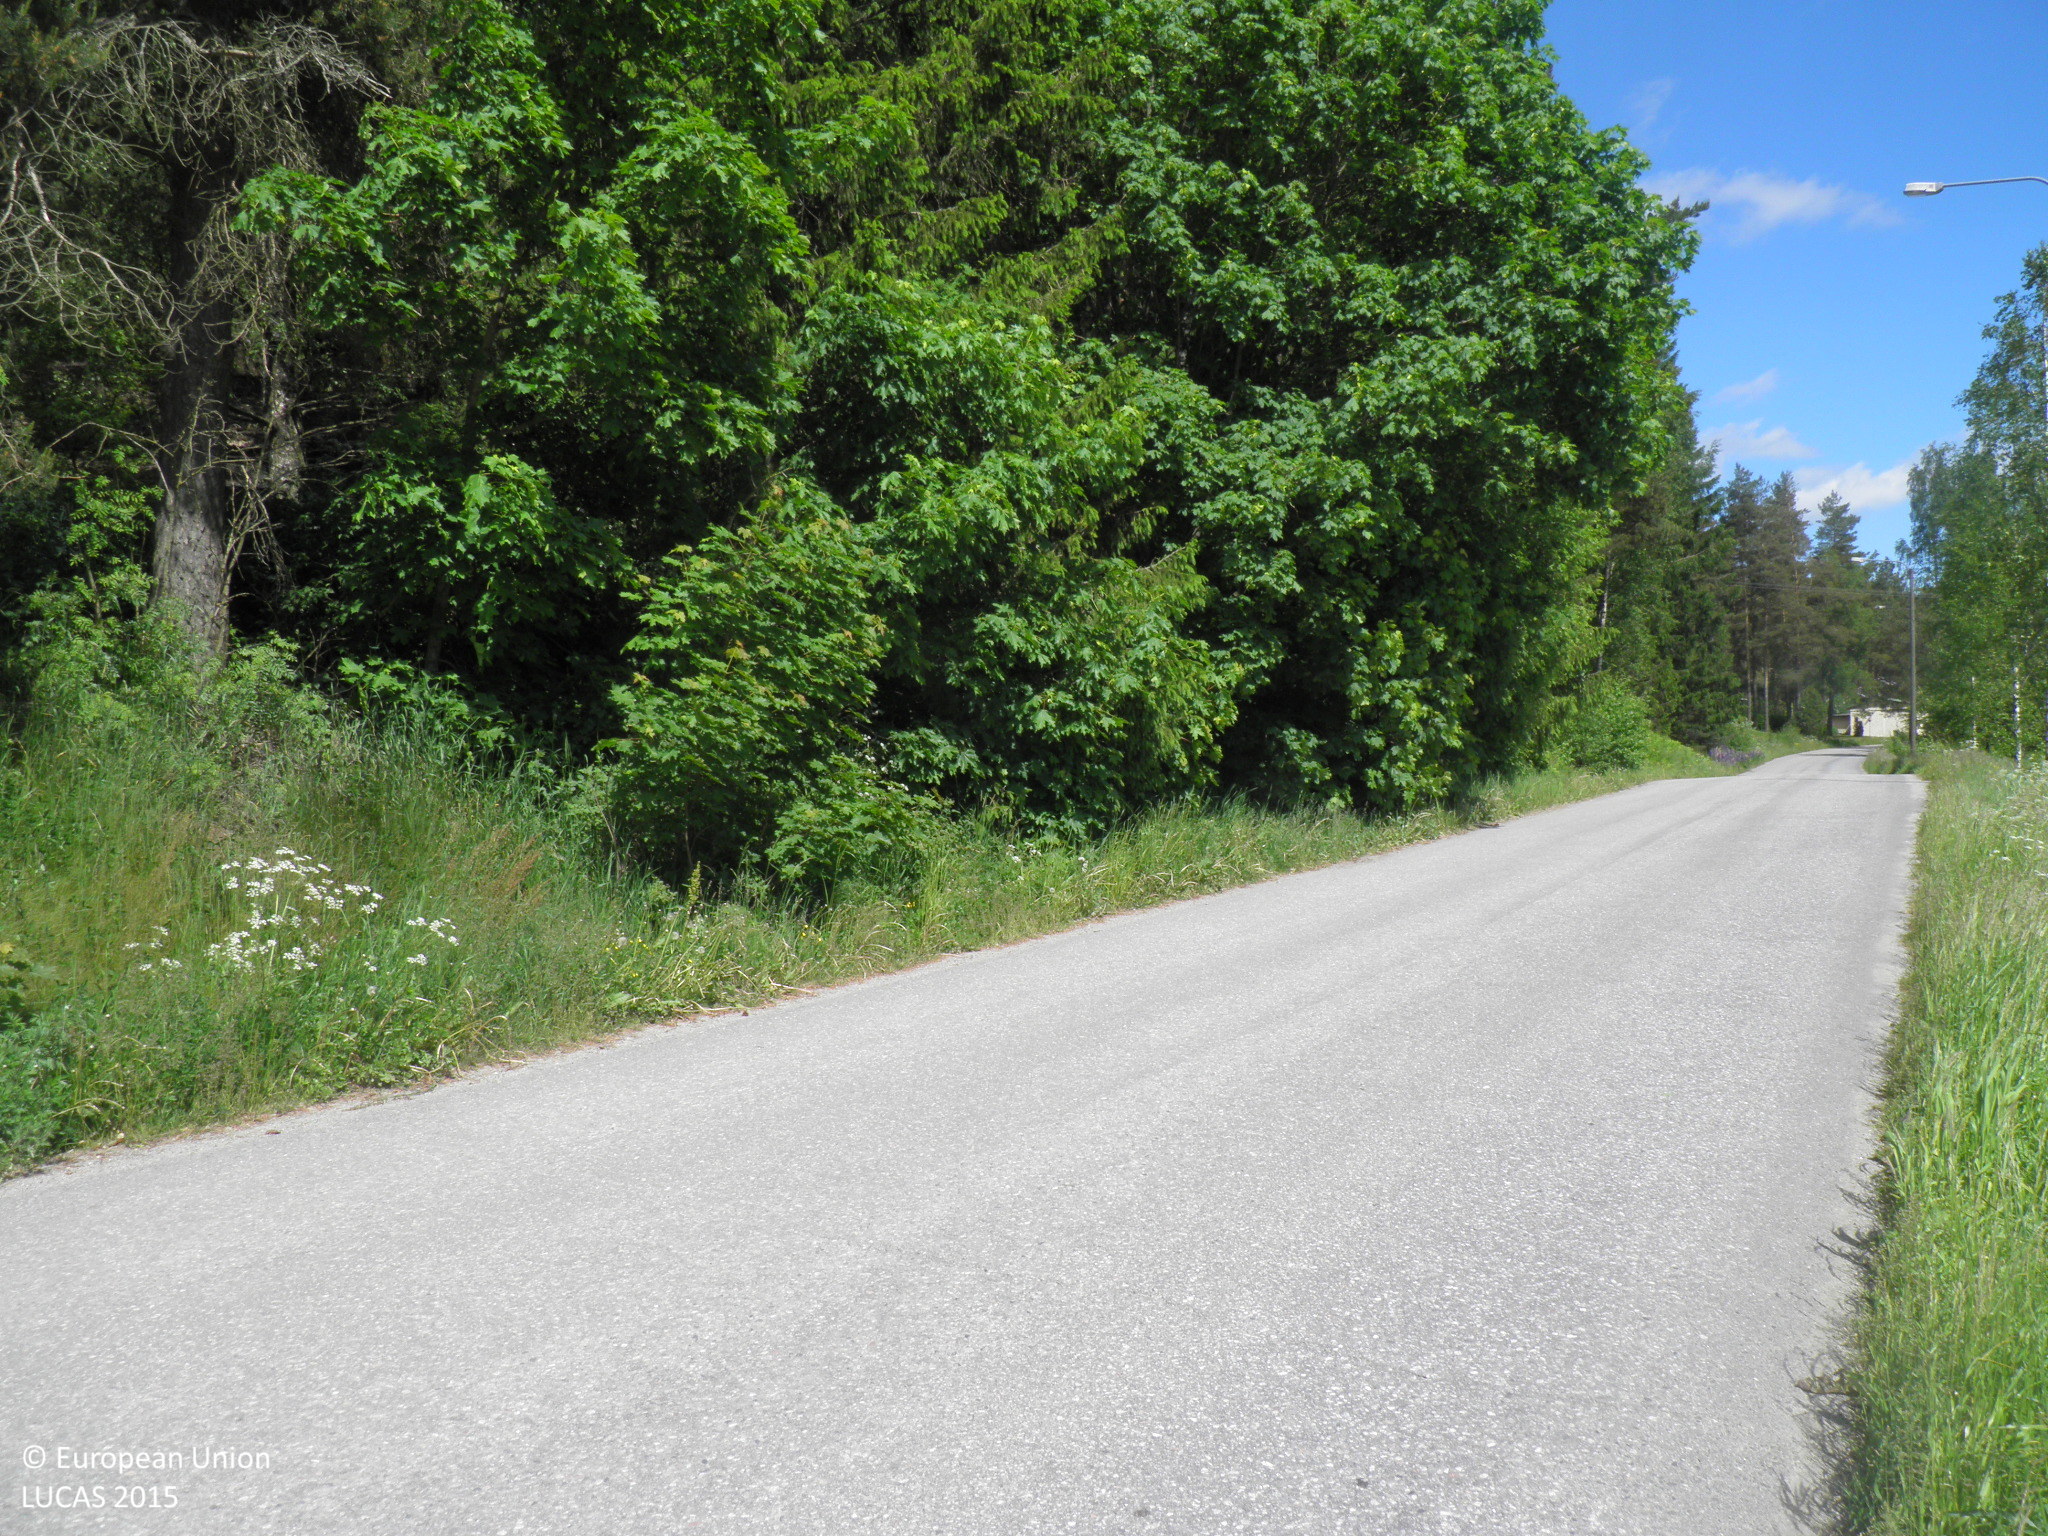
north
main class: Cropland
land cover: Common wheat
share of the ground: > 75 %
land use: Agriculture (excluding fallow land and kitchen gardens)
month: June
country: FI
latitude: 60.3522
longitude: 22.7061
